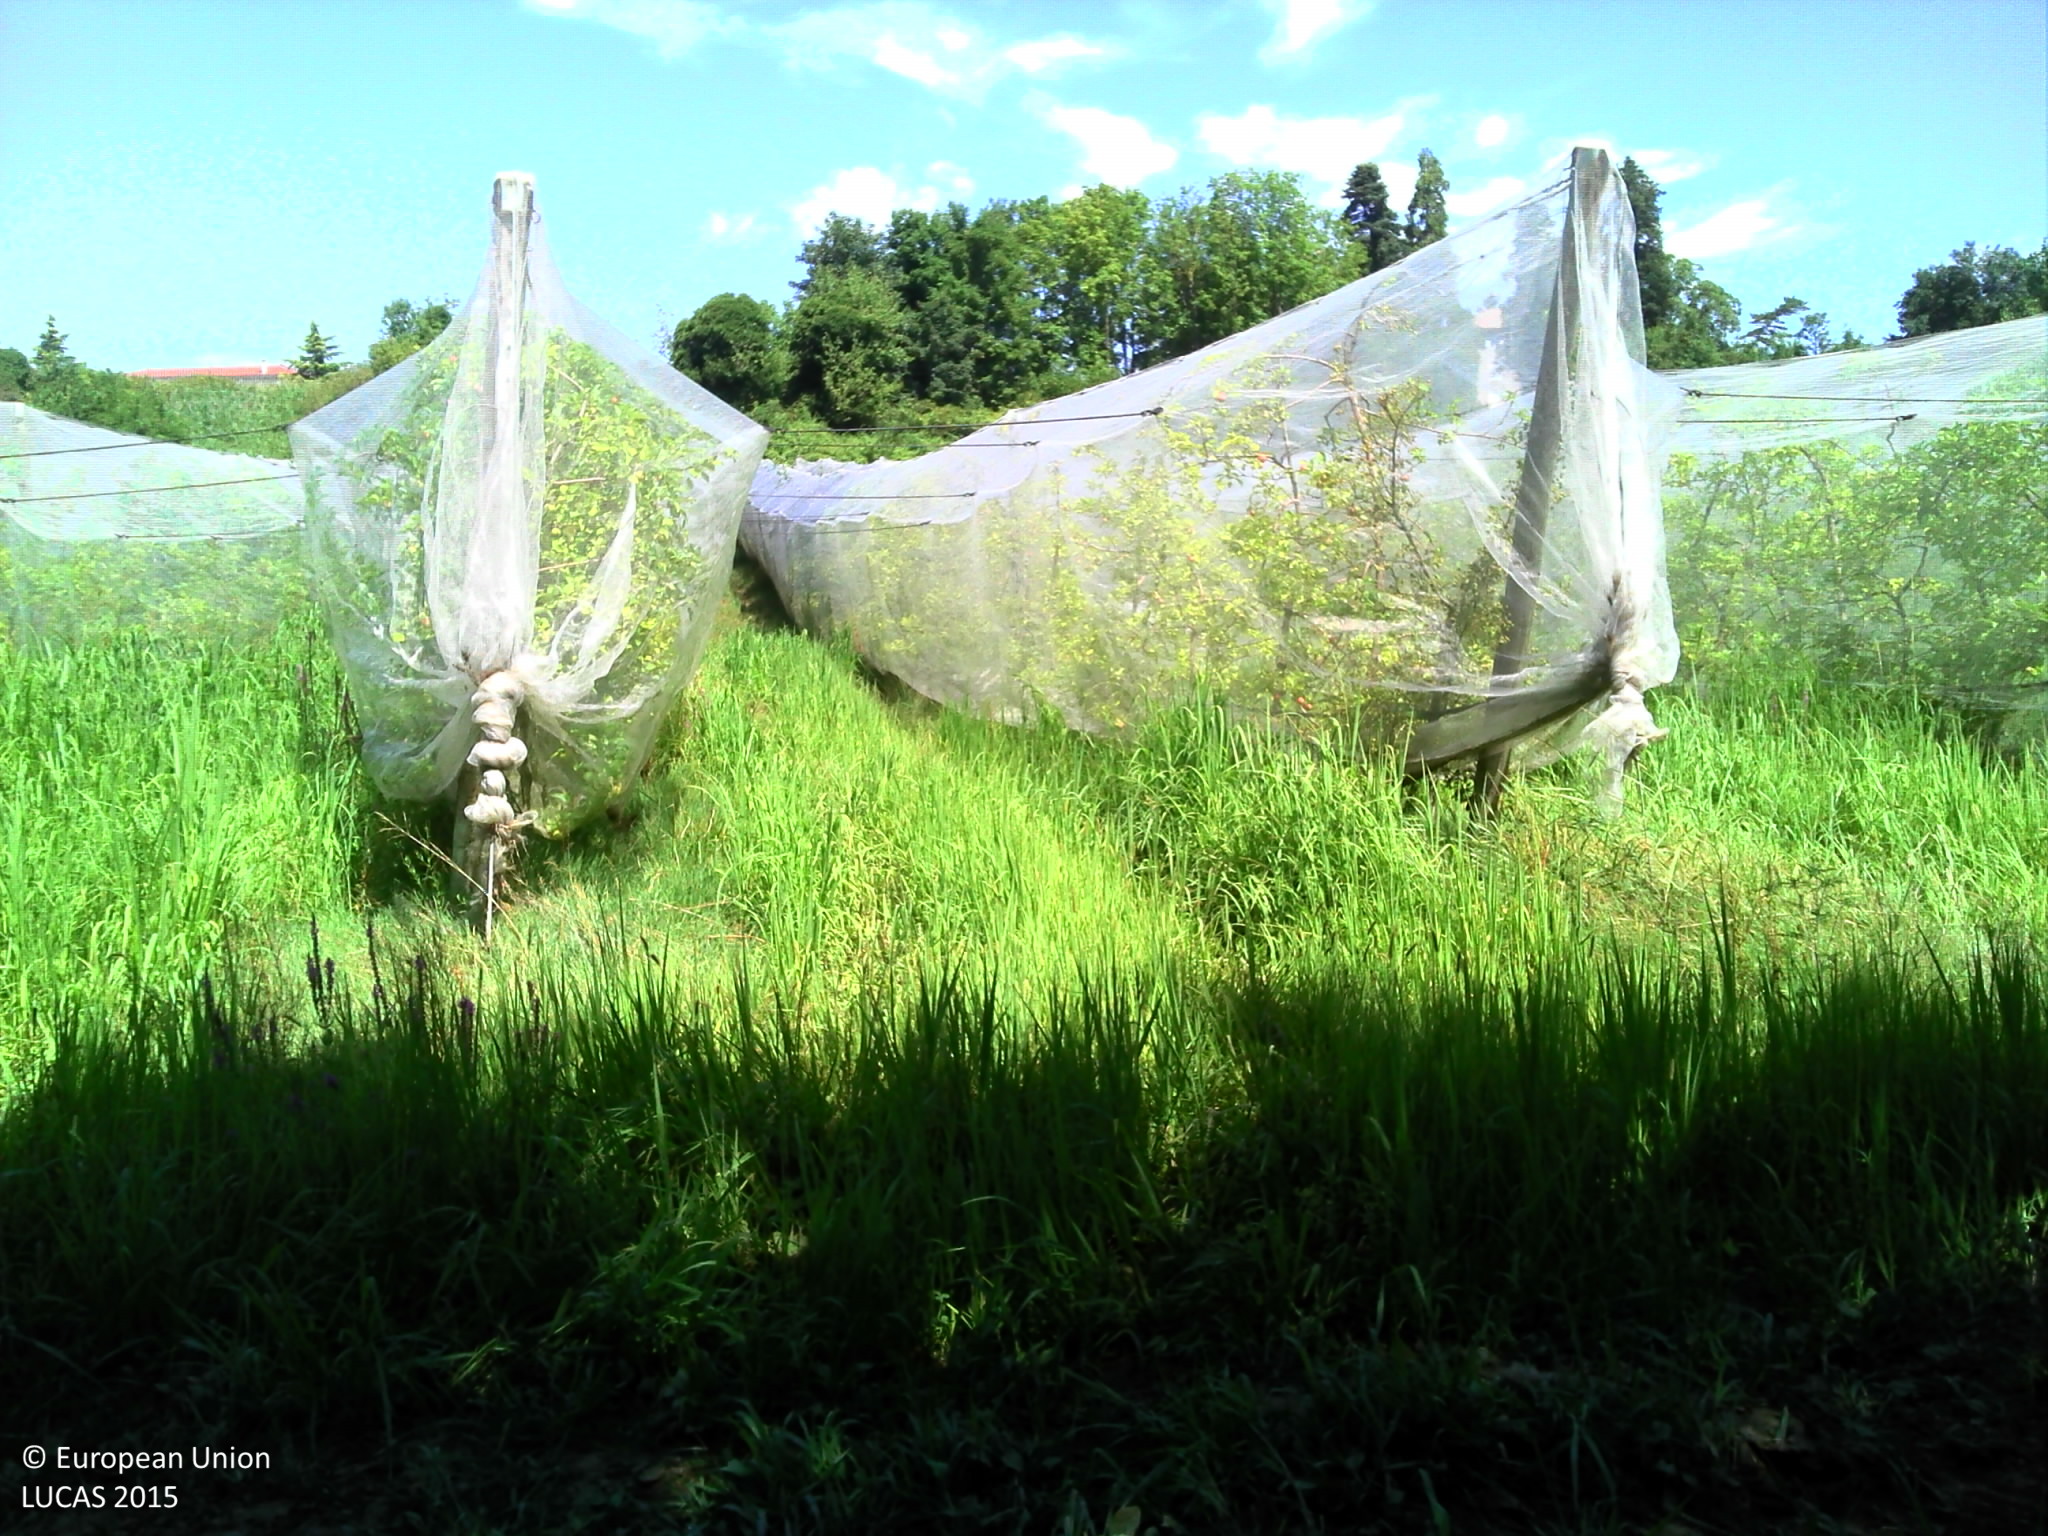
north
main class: Woodland
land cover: Broadleaved woodland
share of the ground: > 75 %
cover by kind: broadleaved forest trees 80 %, herbaceous plants 20 %
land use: Semi-natural and natural areas not in use
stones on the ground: < 10 %
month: July
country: FR
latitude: 45.3265
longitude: 4.8885
